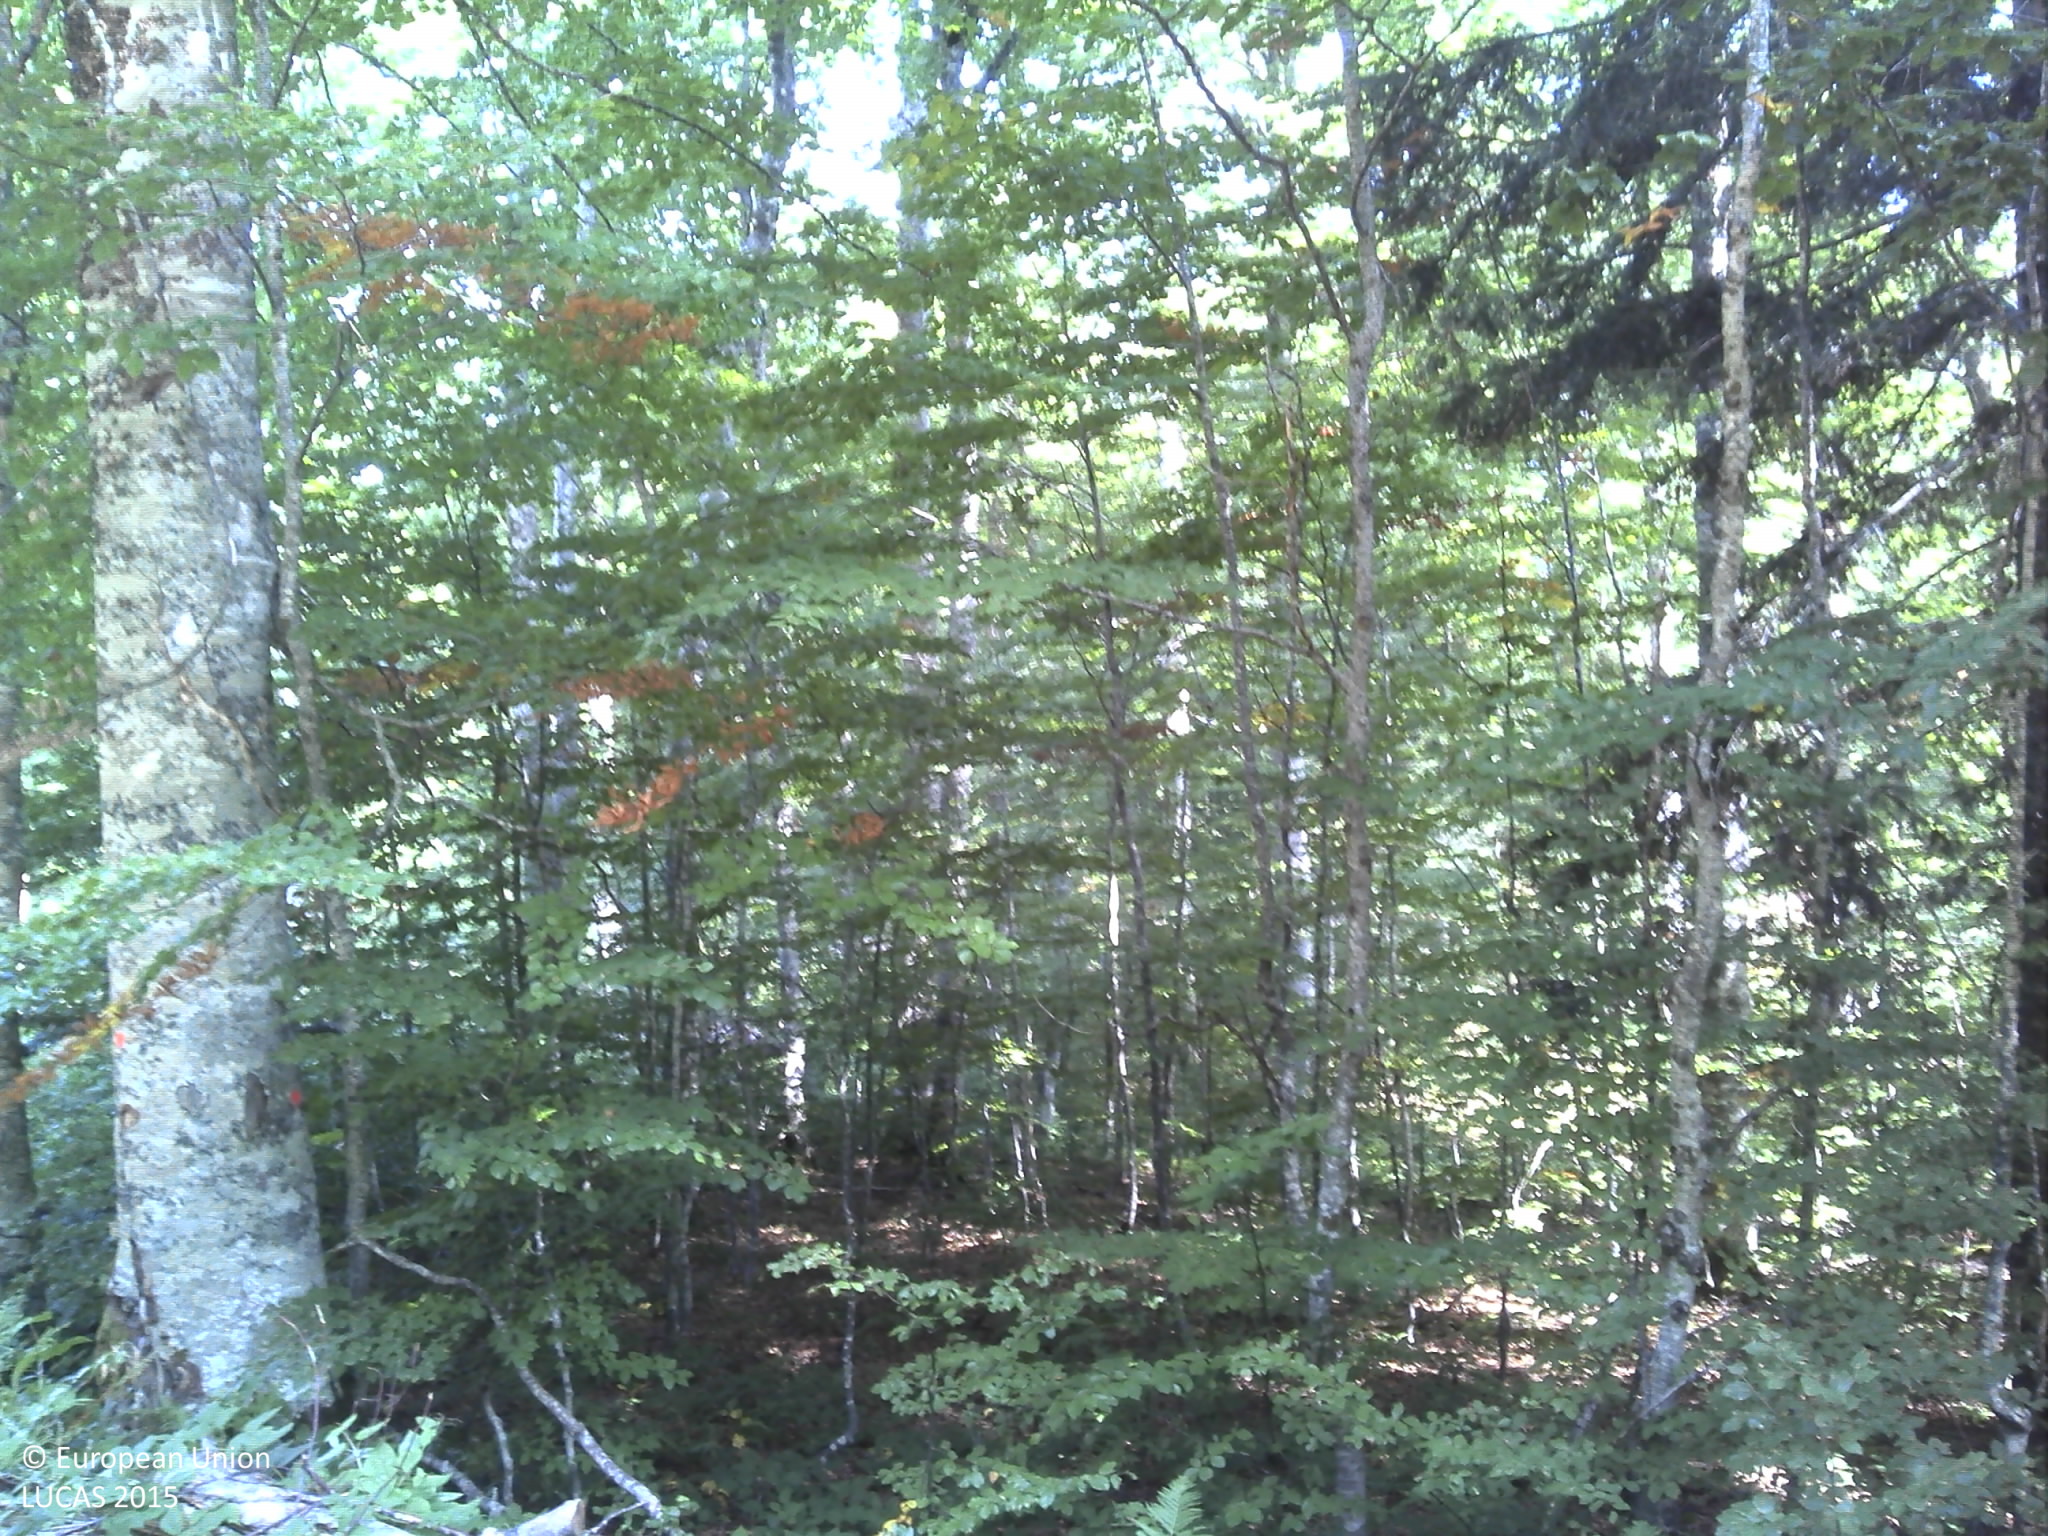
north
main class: Woodland
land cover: Broadleaved woodland
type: mountainous beech forest
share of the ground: > 75 %
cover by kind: broadleaved forest trees 95 %, coniferous forest trees 5 %
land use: Forestry
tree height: > 5 m
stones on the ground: < 10 %
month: September
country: HR
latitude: 44.4725
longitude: 15.8895
